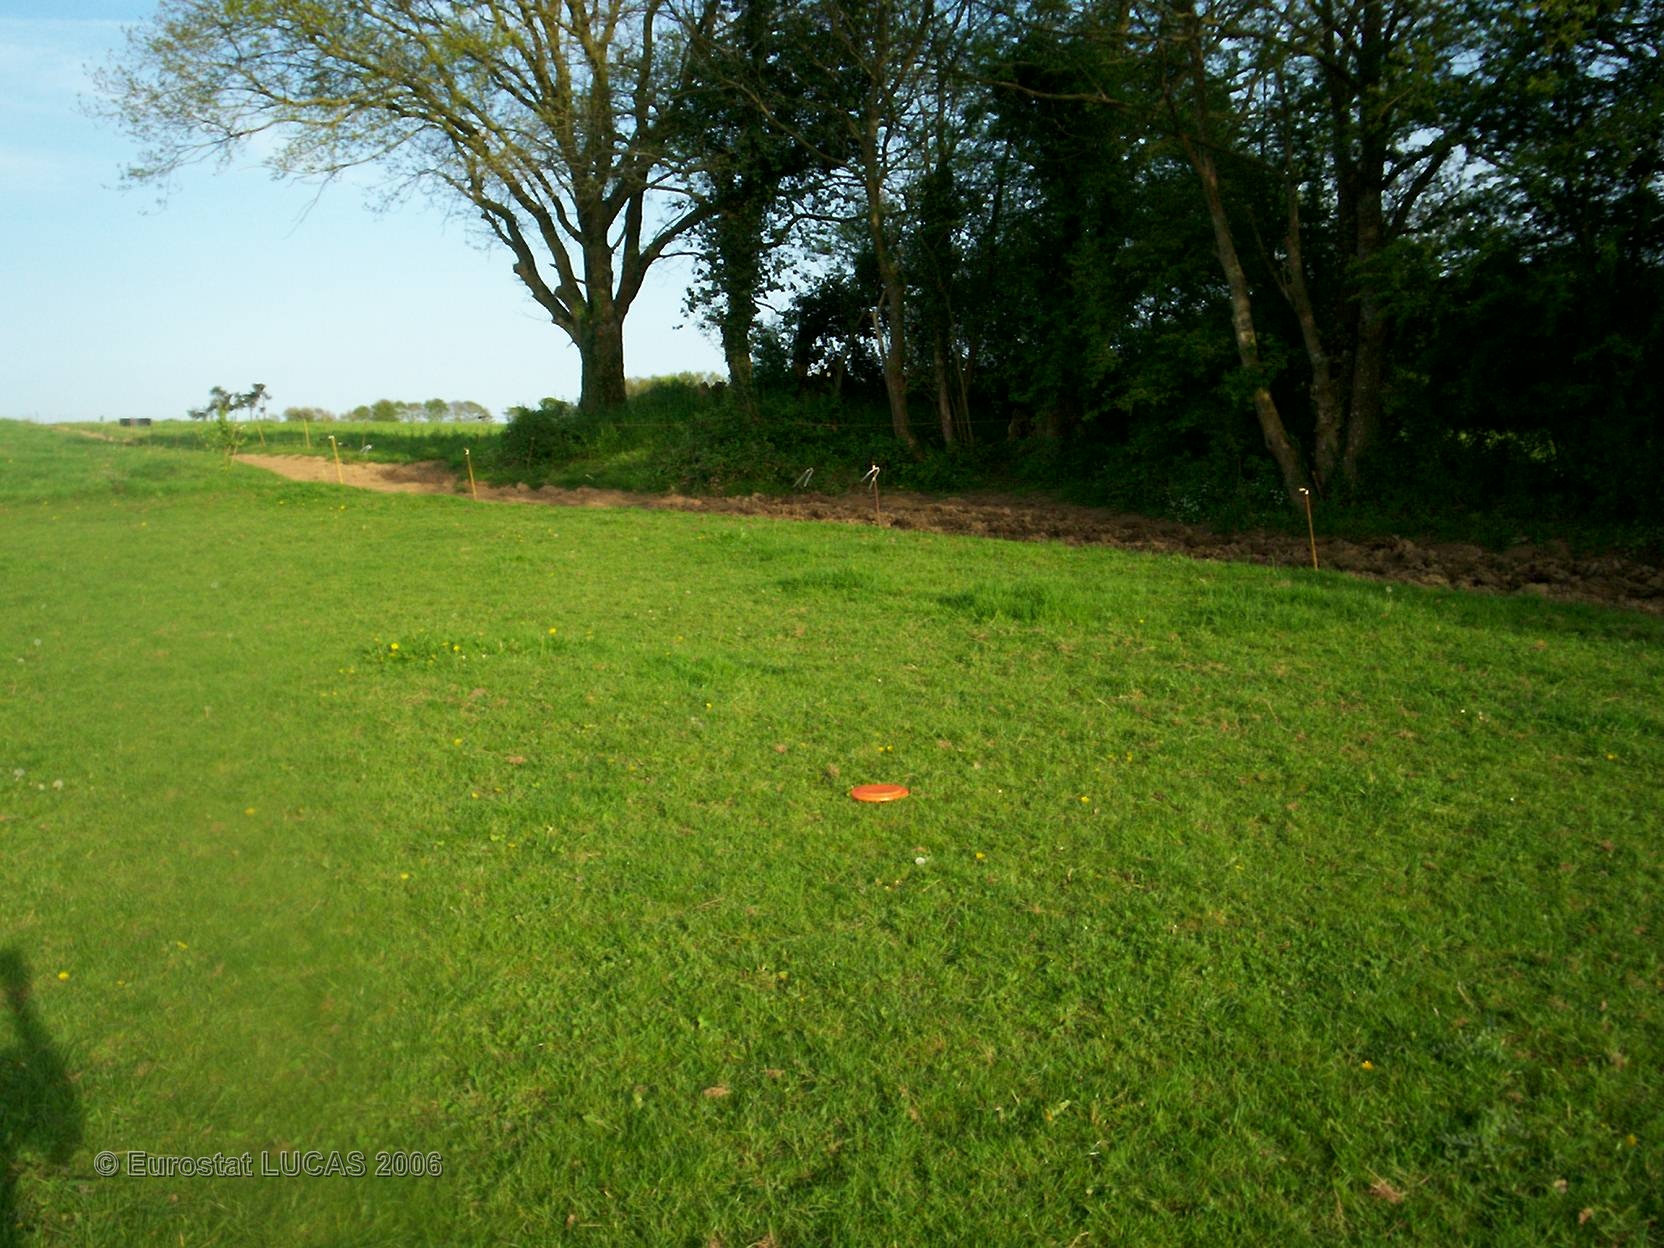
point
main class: Grassland
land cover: Grassland without tree/shrub cover
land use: Agriculture (excluding fallow land and kitchen gardens)
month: May
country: FR
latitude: 47.9945
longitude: -2.8635
